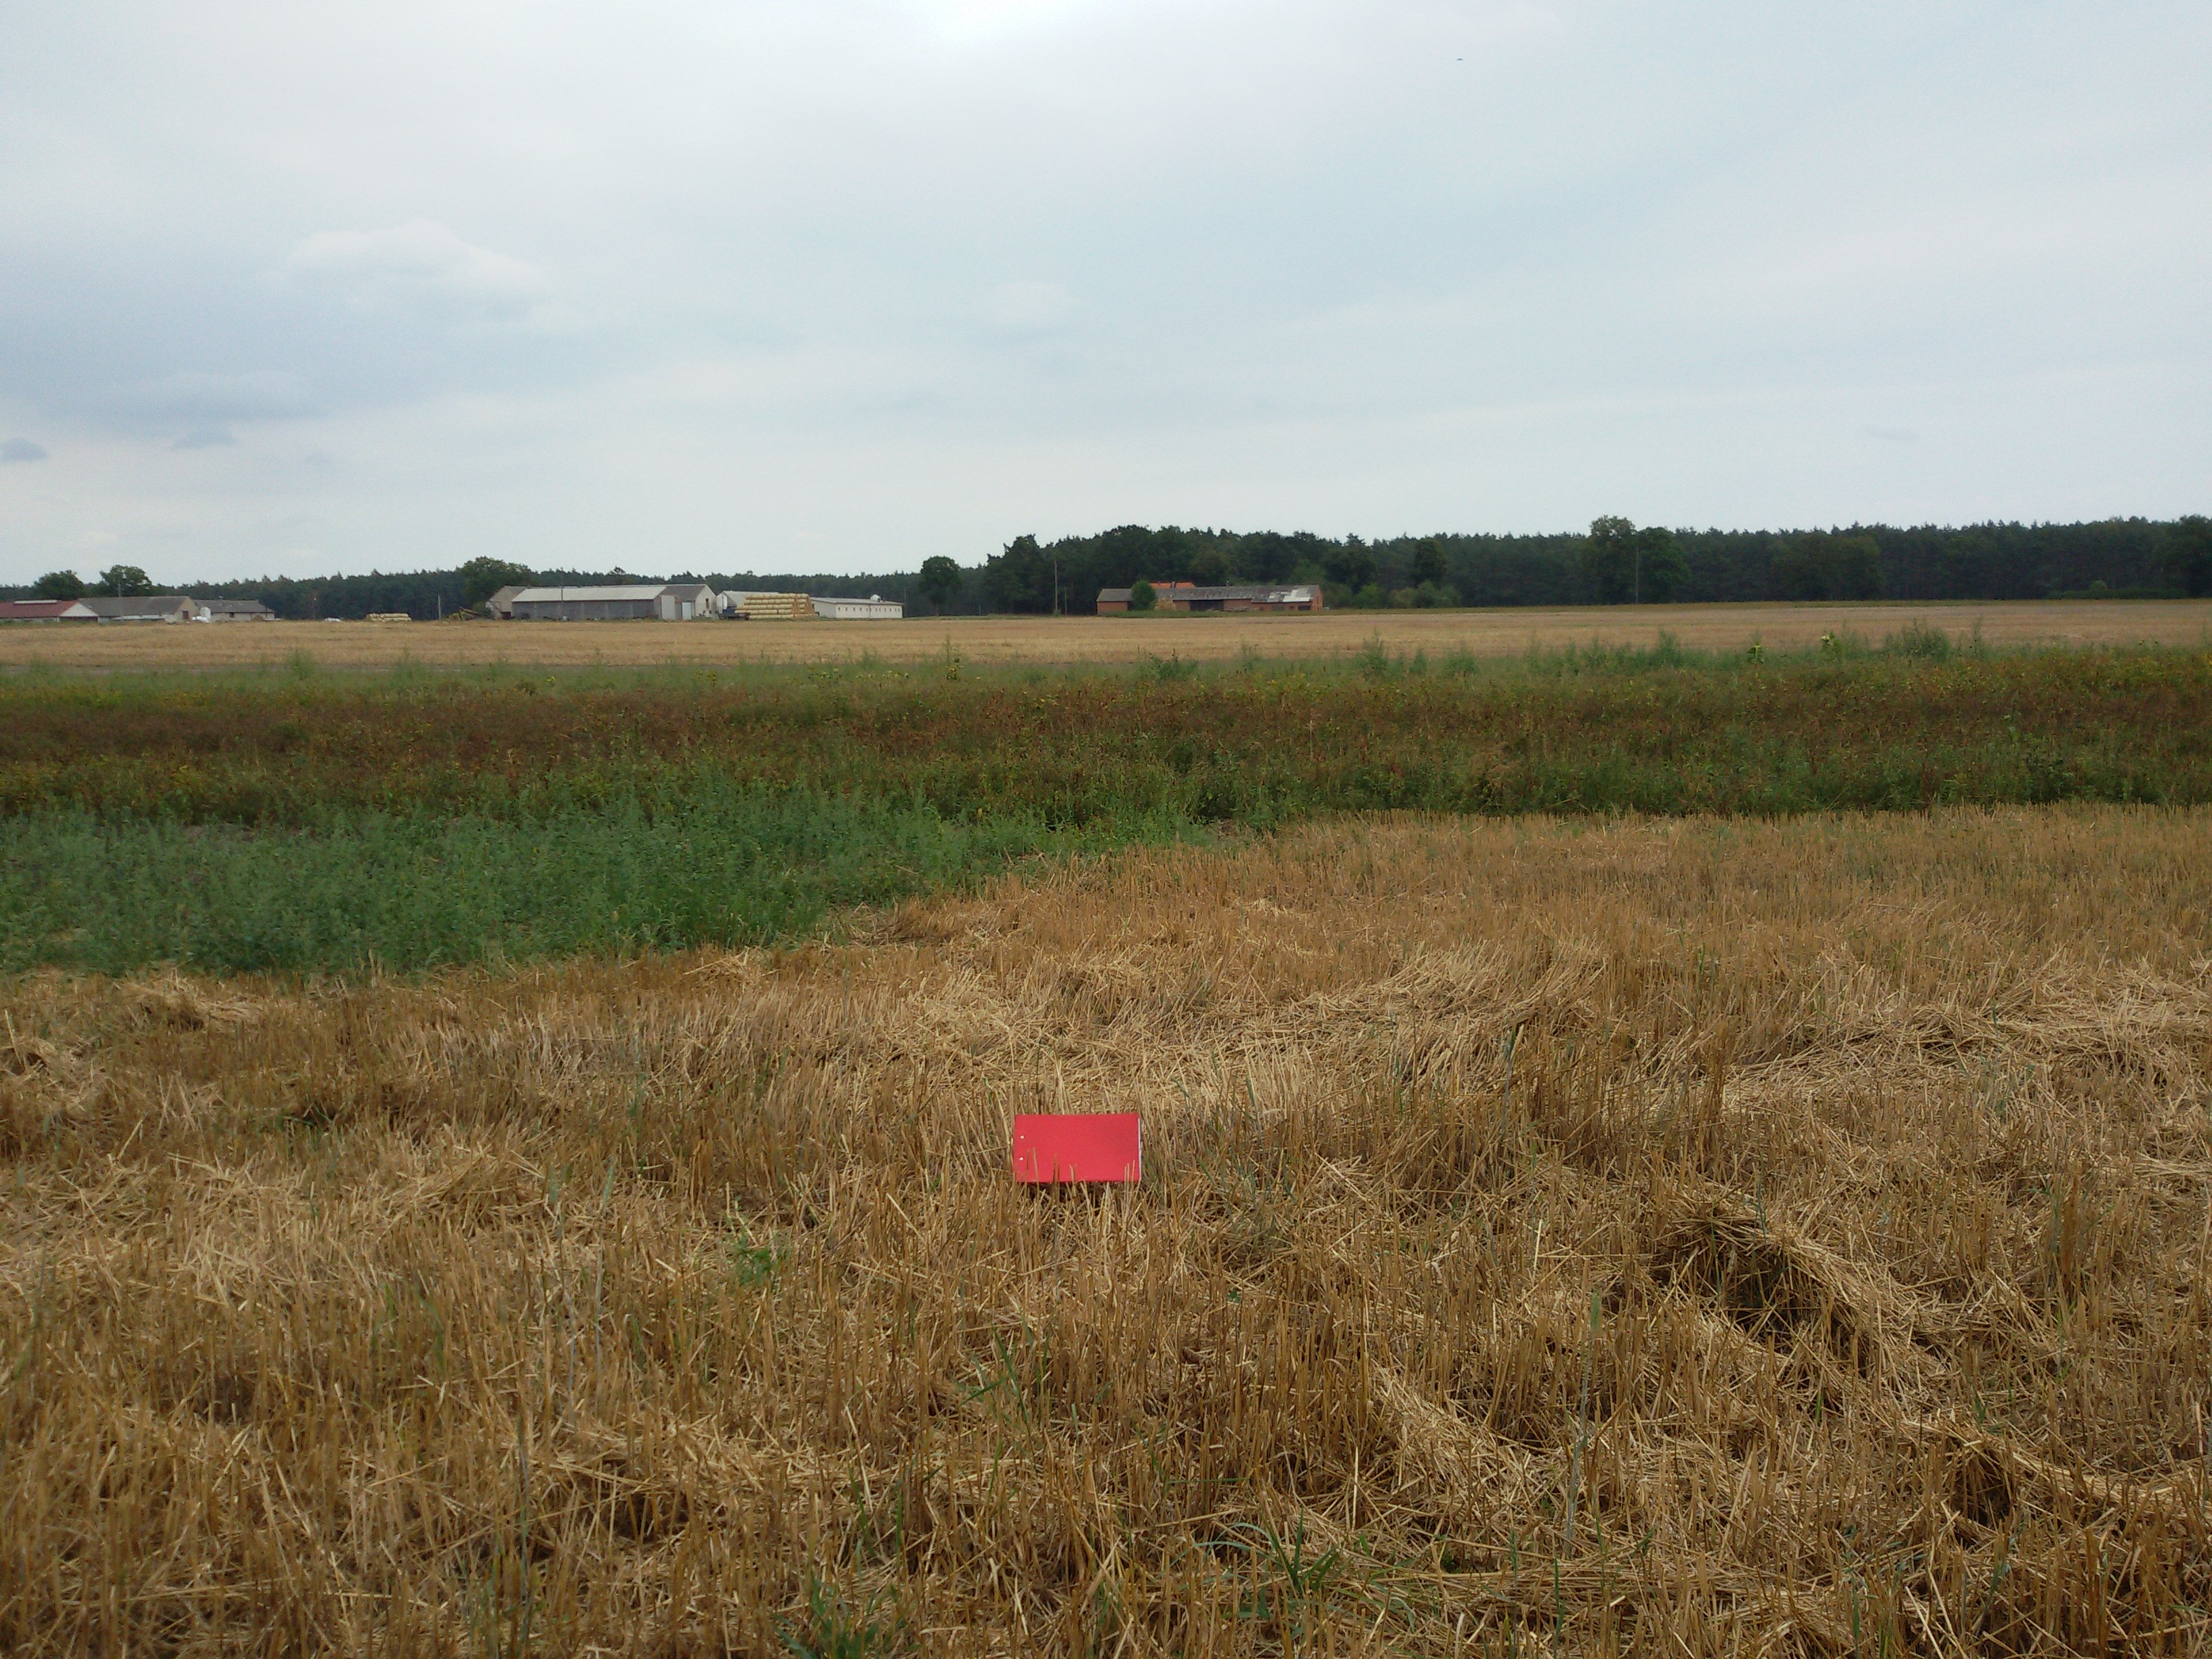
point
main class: Cropland
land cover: Common wheat
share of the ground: > 75 %
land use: Agriculture (excluding fallow land and kitchen gardens)
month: August
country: PL
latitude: 51.7183
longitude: 17.8749
